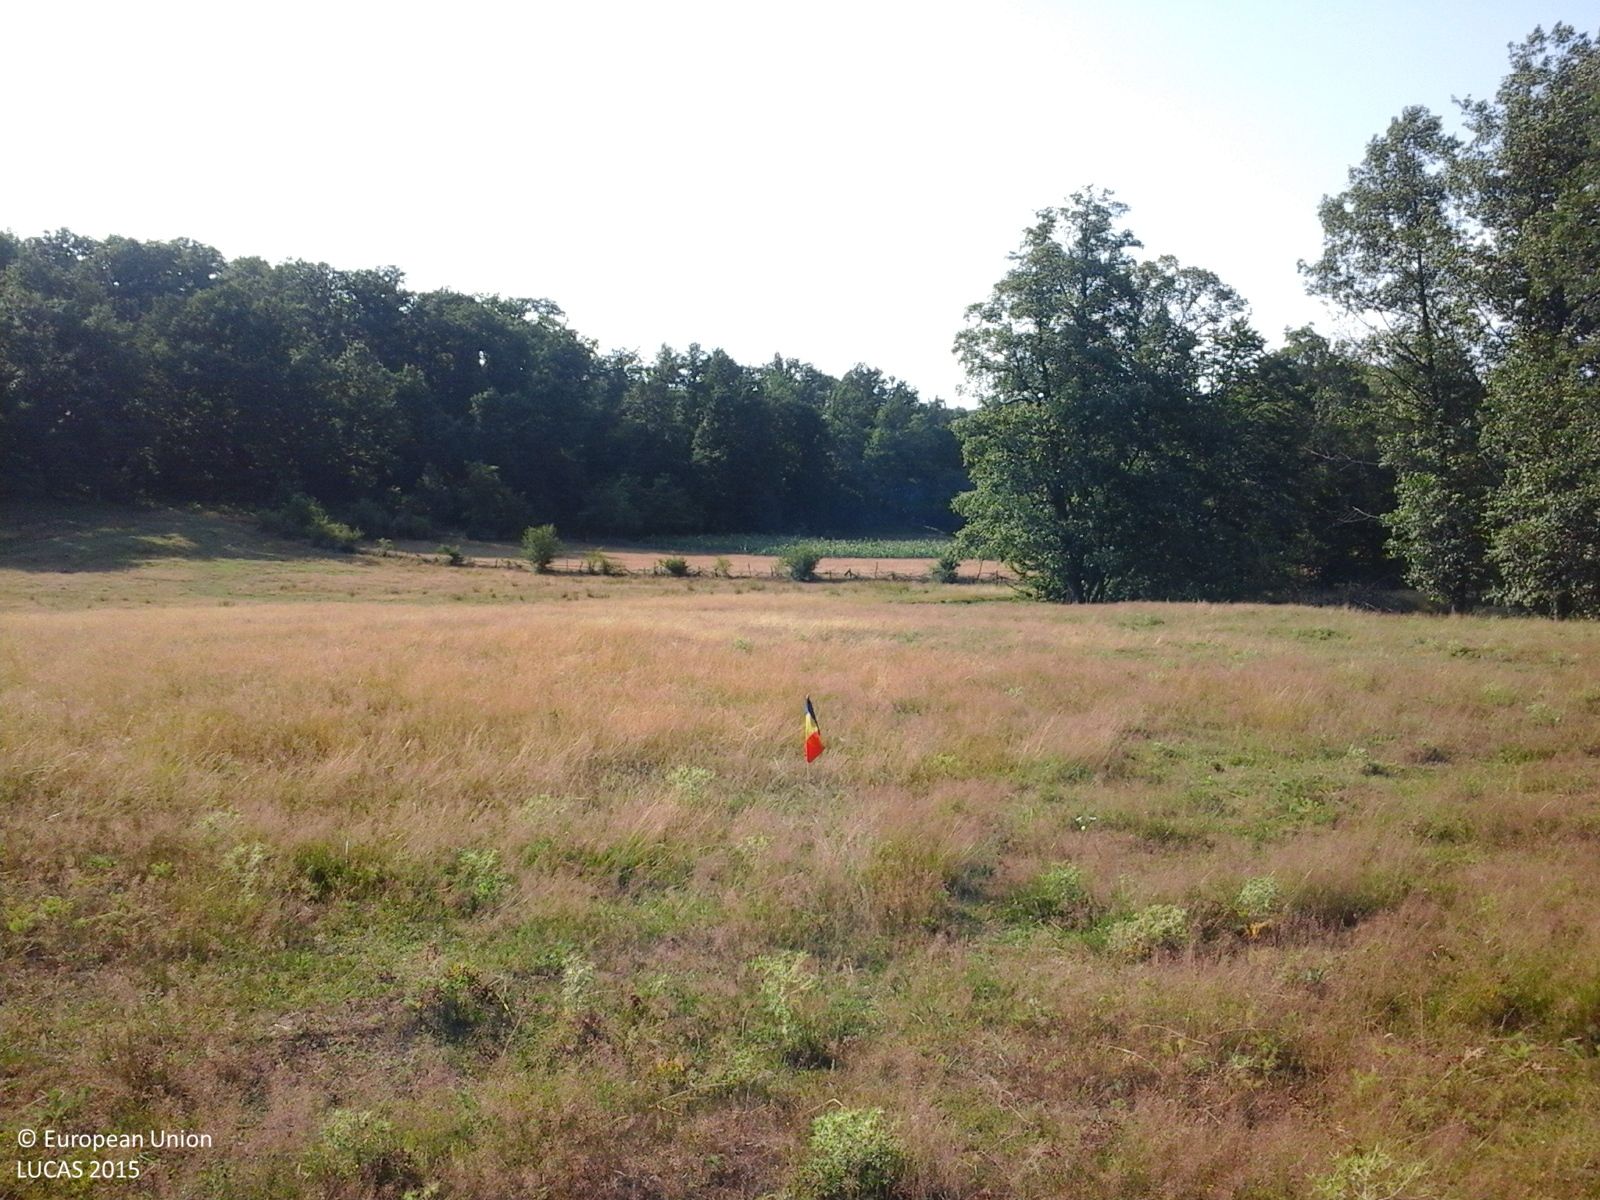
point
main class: Grassland
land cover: Grassland without tree/shrub cover
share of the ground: > 75 %
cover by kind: herbaceous plants 100 %
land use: Agriculture (excluding fallow land and kitchen gardens)
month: July
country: RO
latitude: 44.9349
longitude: 24.5079
